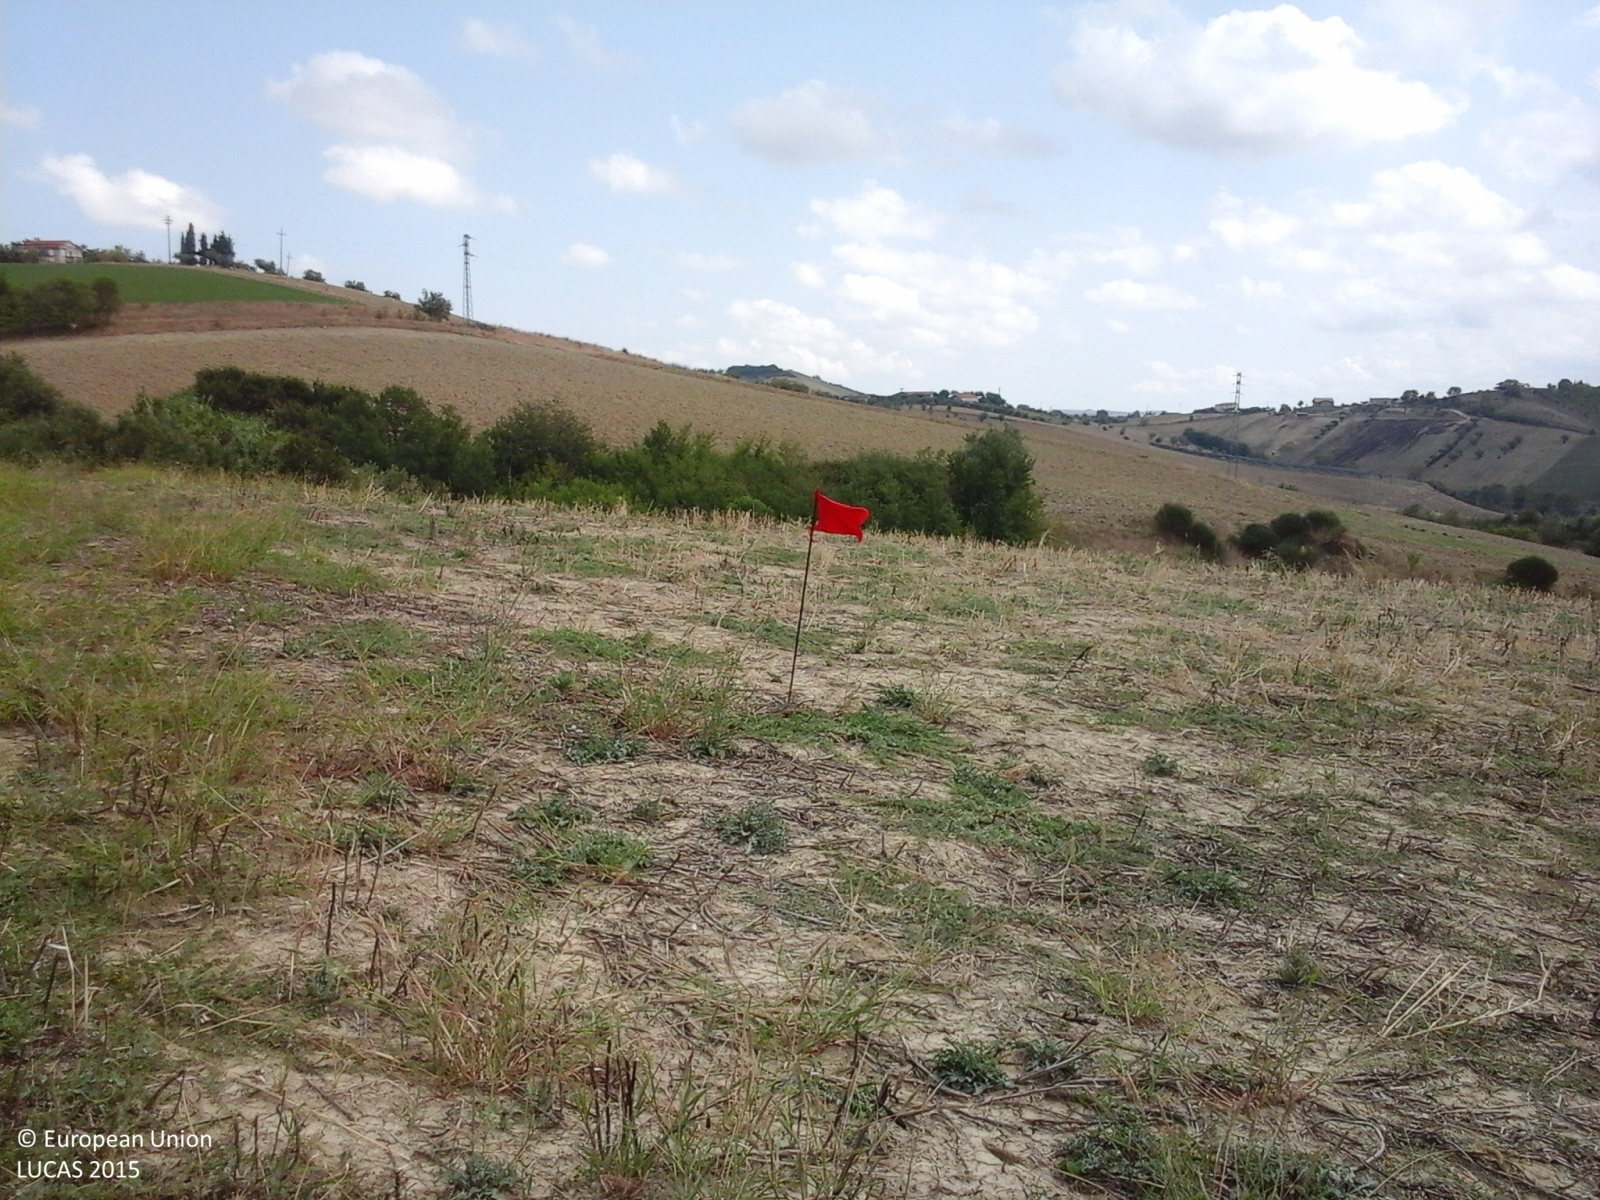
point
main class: Cropland
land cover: Dry pulses
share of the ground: < 10 %
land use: Agriculture (excluding fallow land and kitchen gardens)
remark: Harvested field
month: August
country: IT
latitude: 42.7269
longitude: 13.8117
